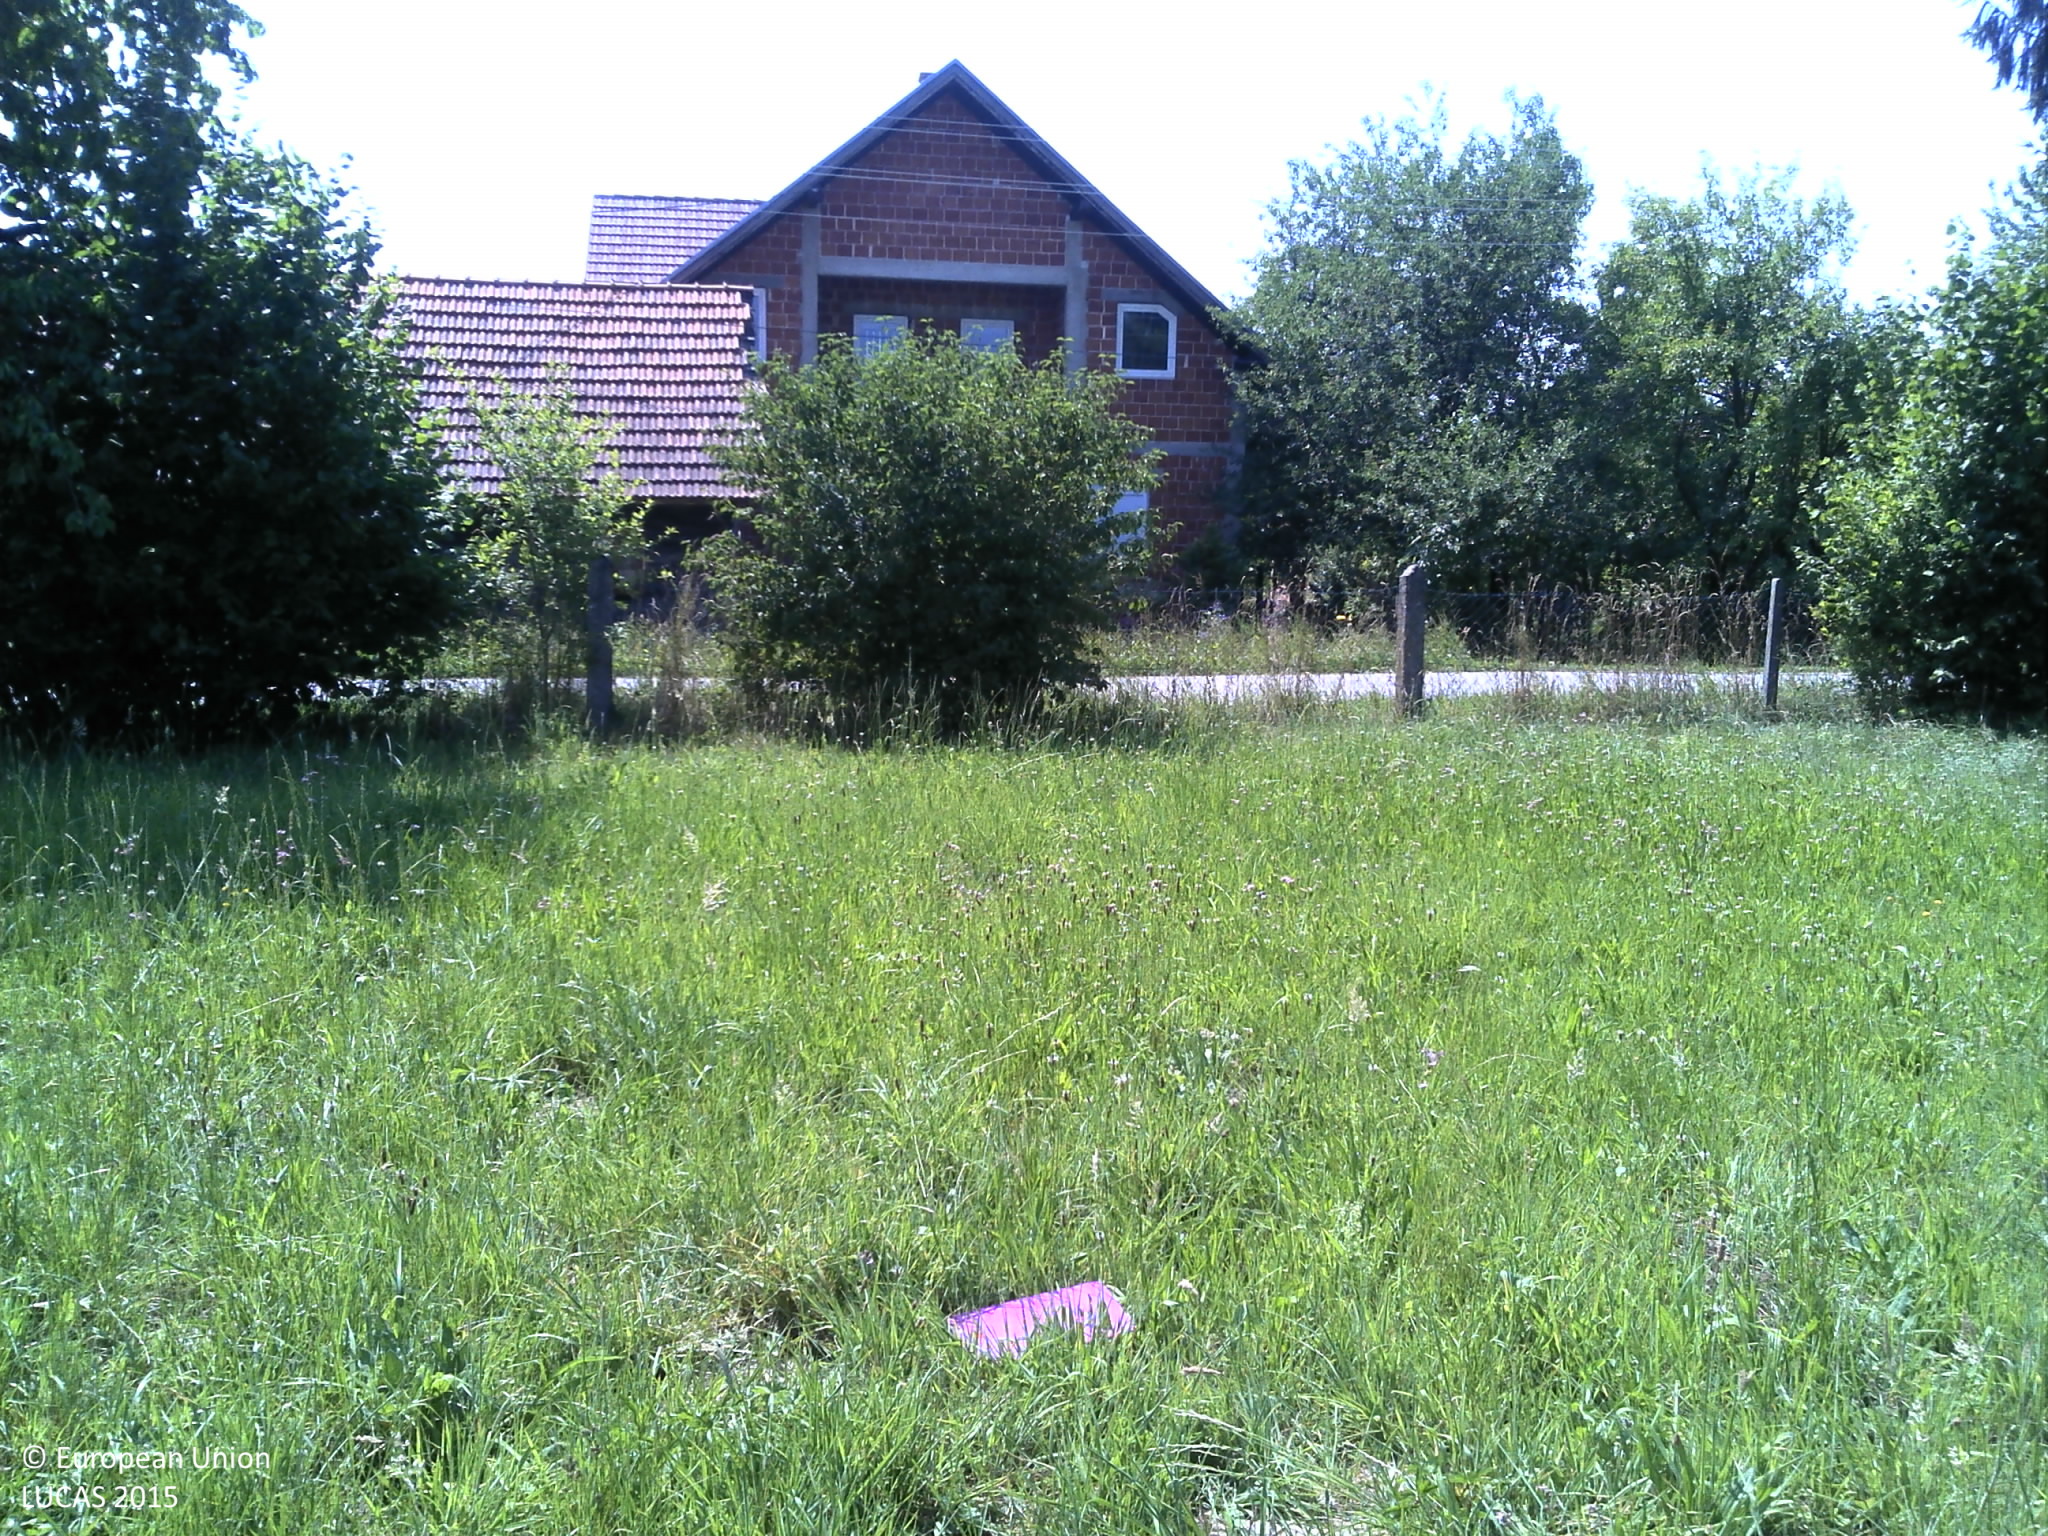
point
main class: Grassland
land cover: Grassland without tree/shrub cover
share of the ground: > 75 %
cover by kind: herbaceous plants 100 %
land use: Semi-natural and natural areas not in use
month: July
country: HR
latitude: 45.7649
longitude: 16.6471
